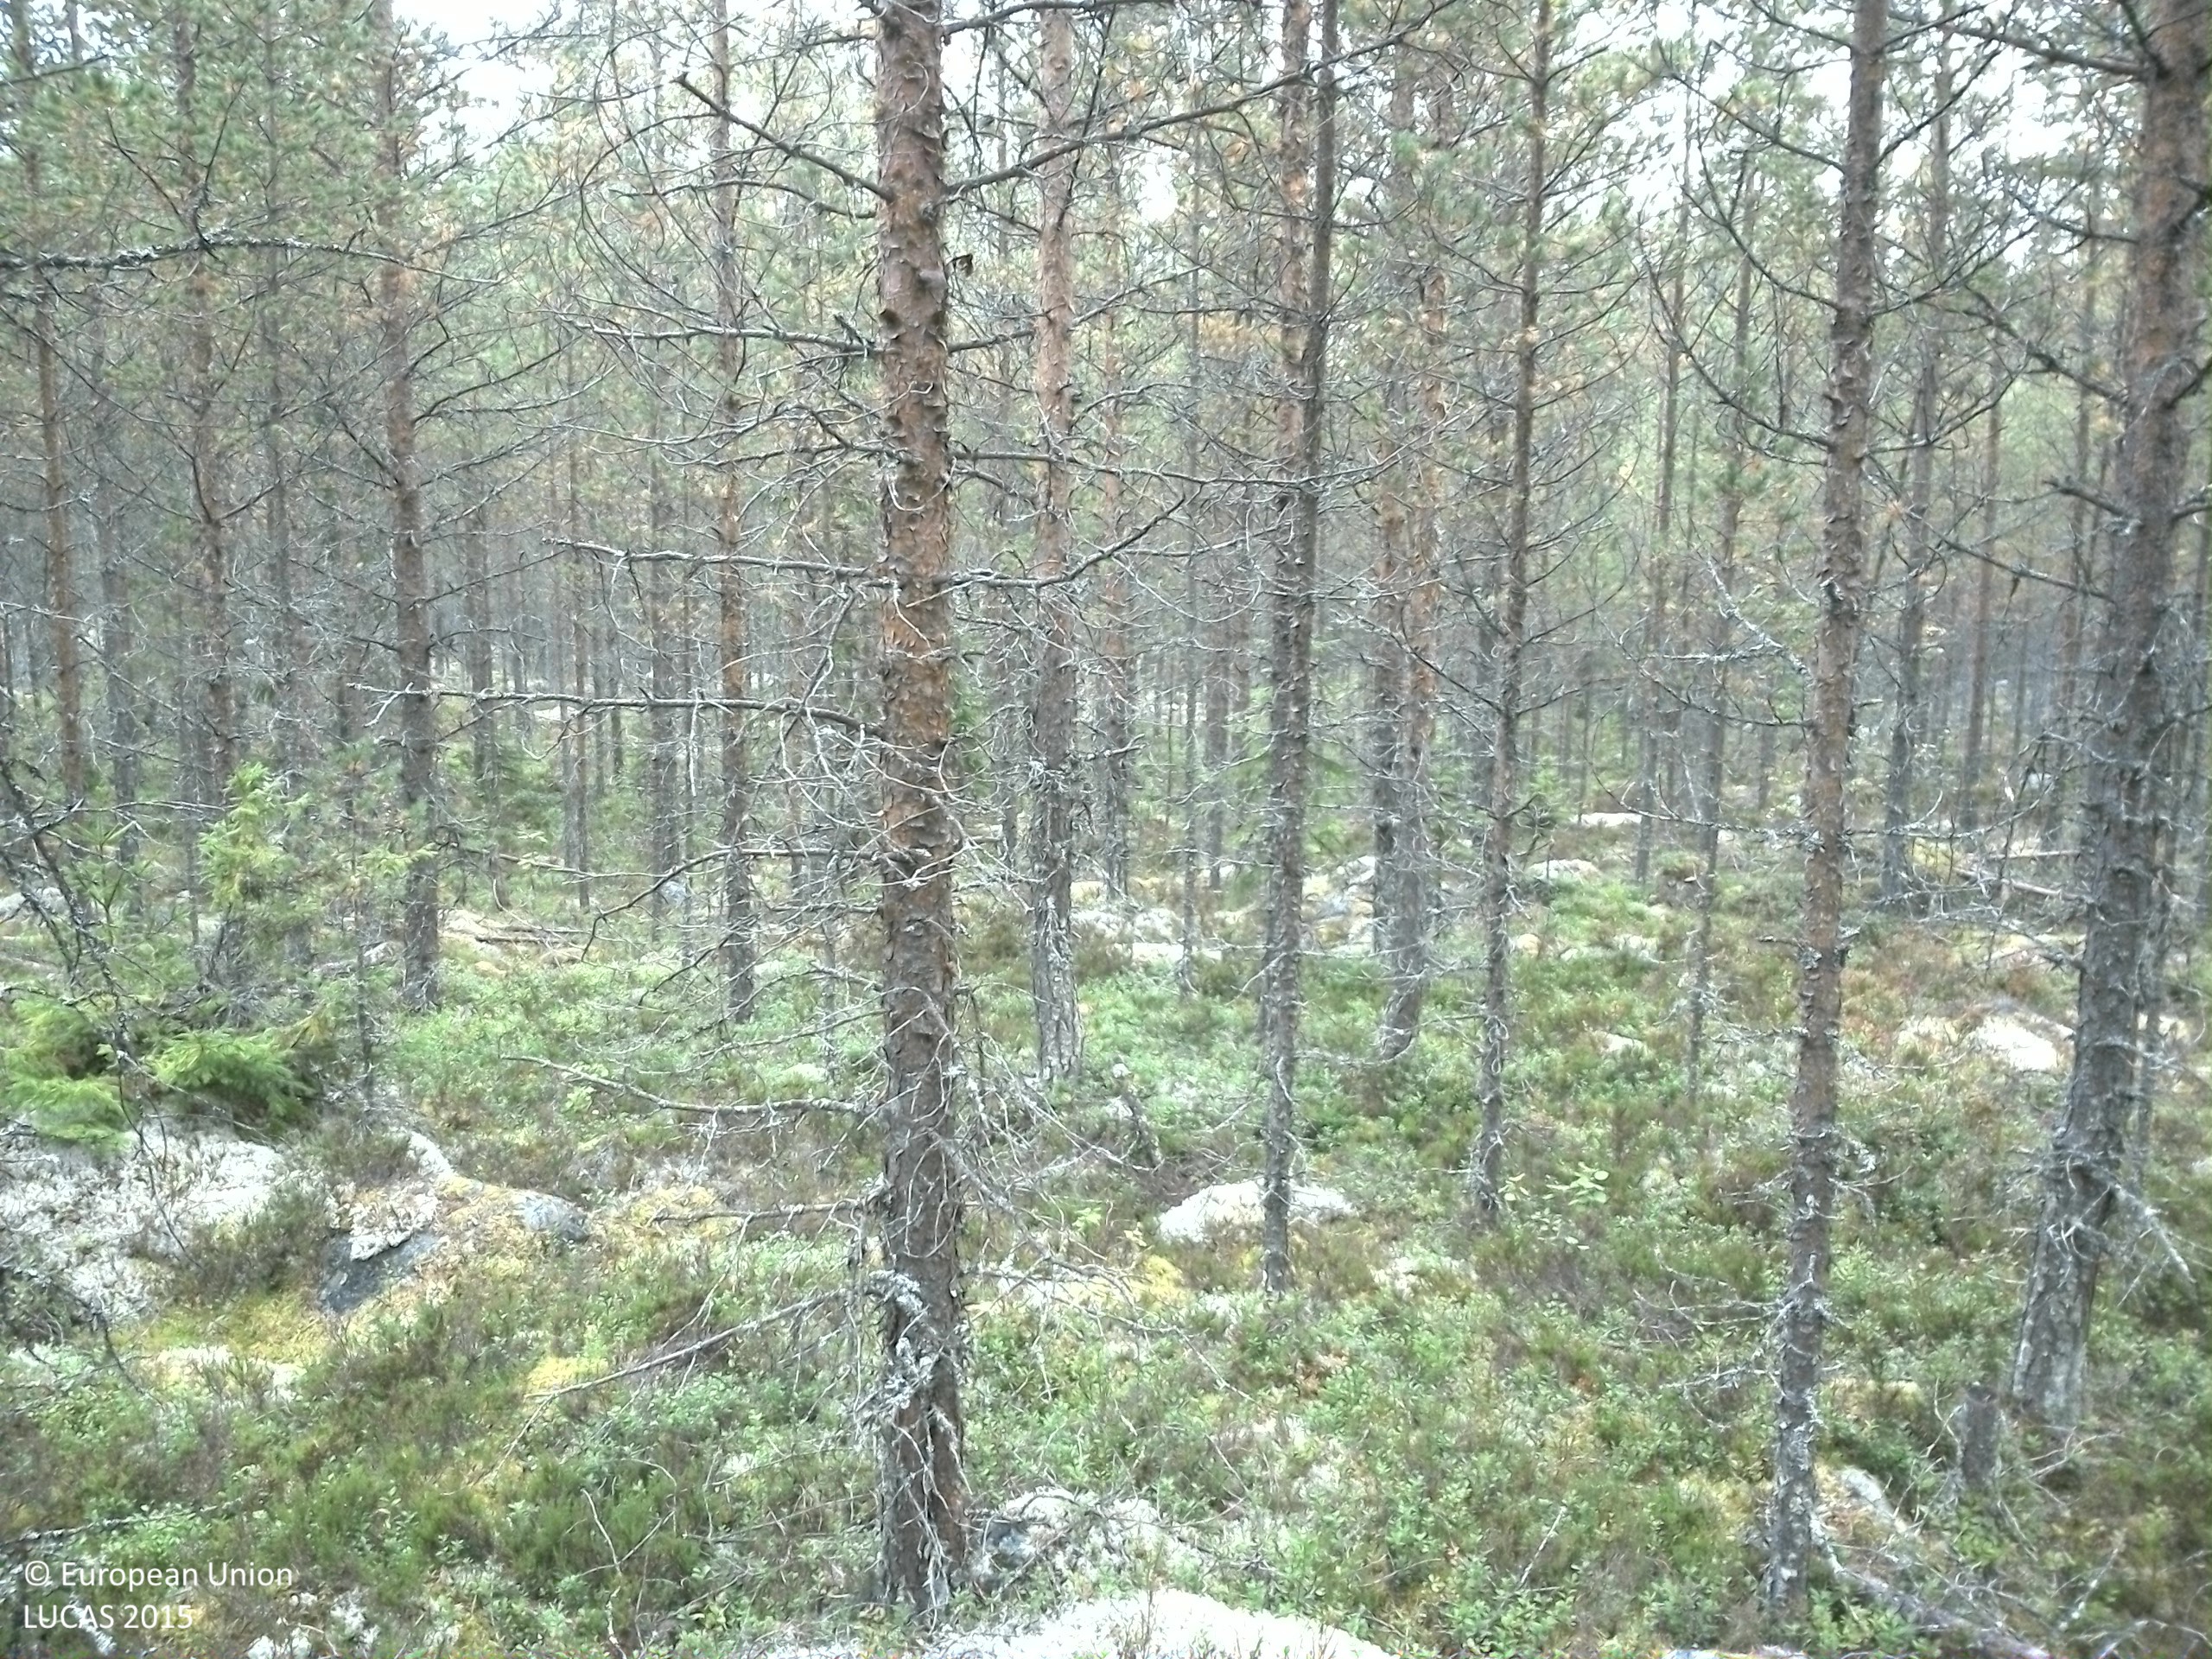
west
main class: Woodland
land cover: Pine dominated coniferous woodland
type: boreal forest
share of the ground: > 75 %
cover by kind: coniferous forest trees 75 %, shrubs 25 %
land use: Forestry
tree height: < 5 m
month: September
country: SE
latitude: 61.5318
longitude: 15.1181
